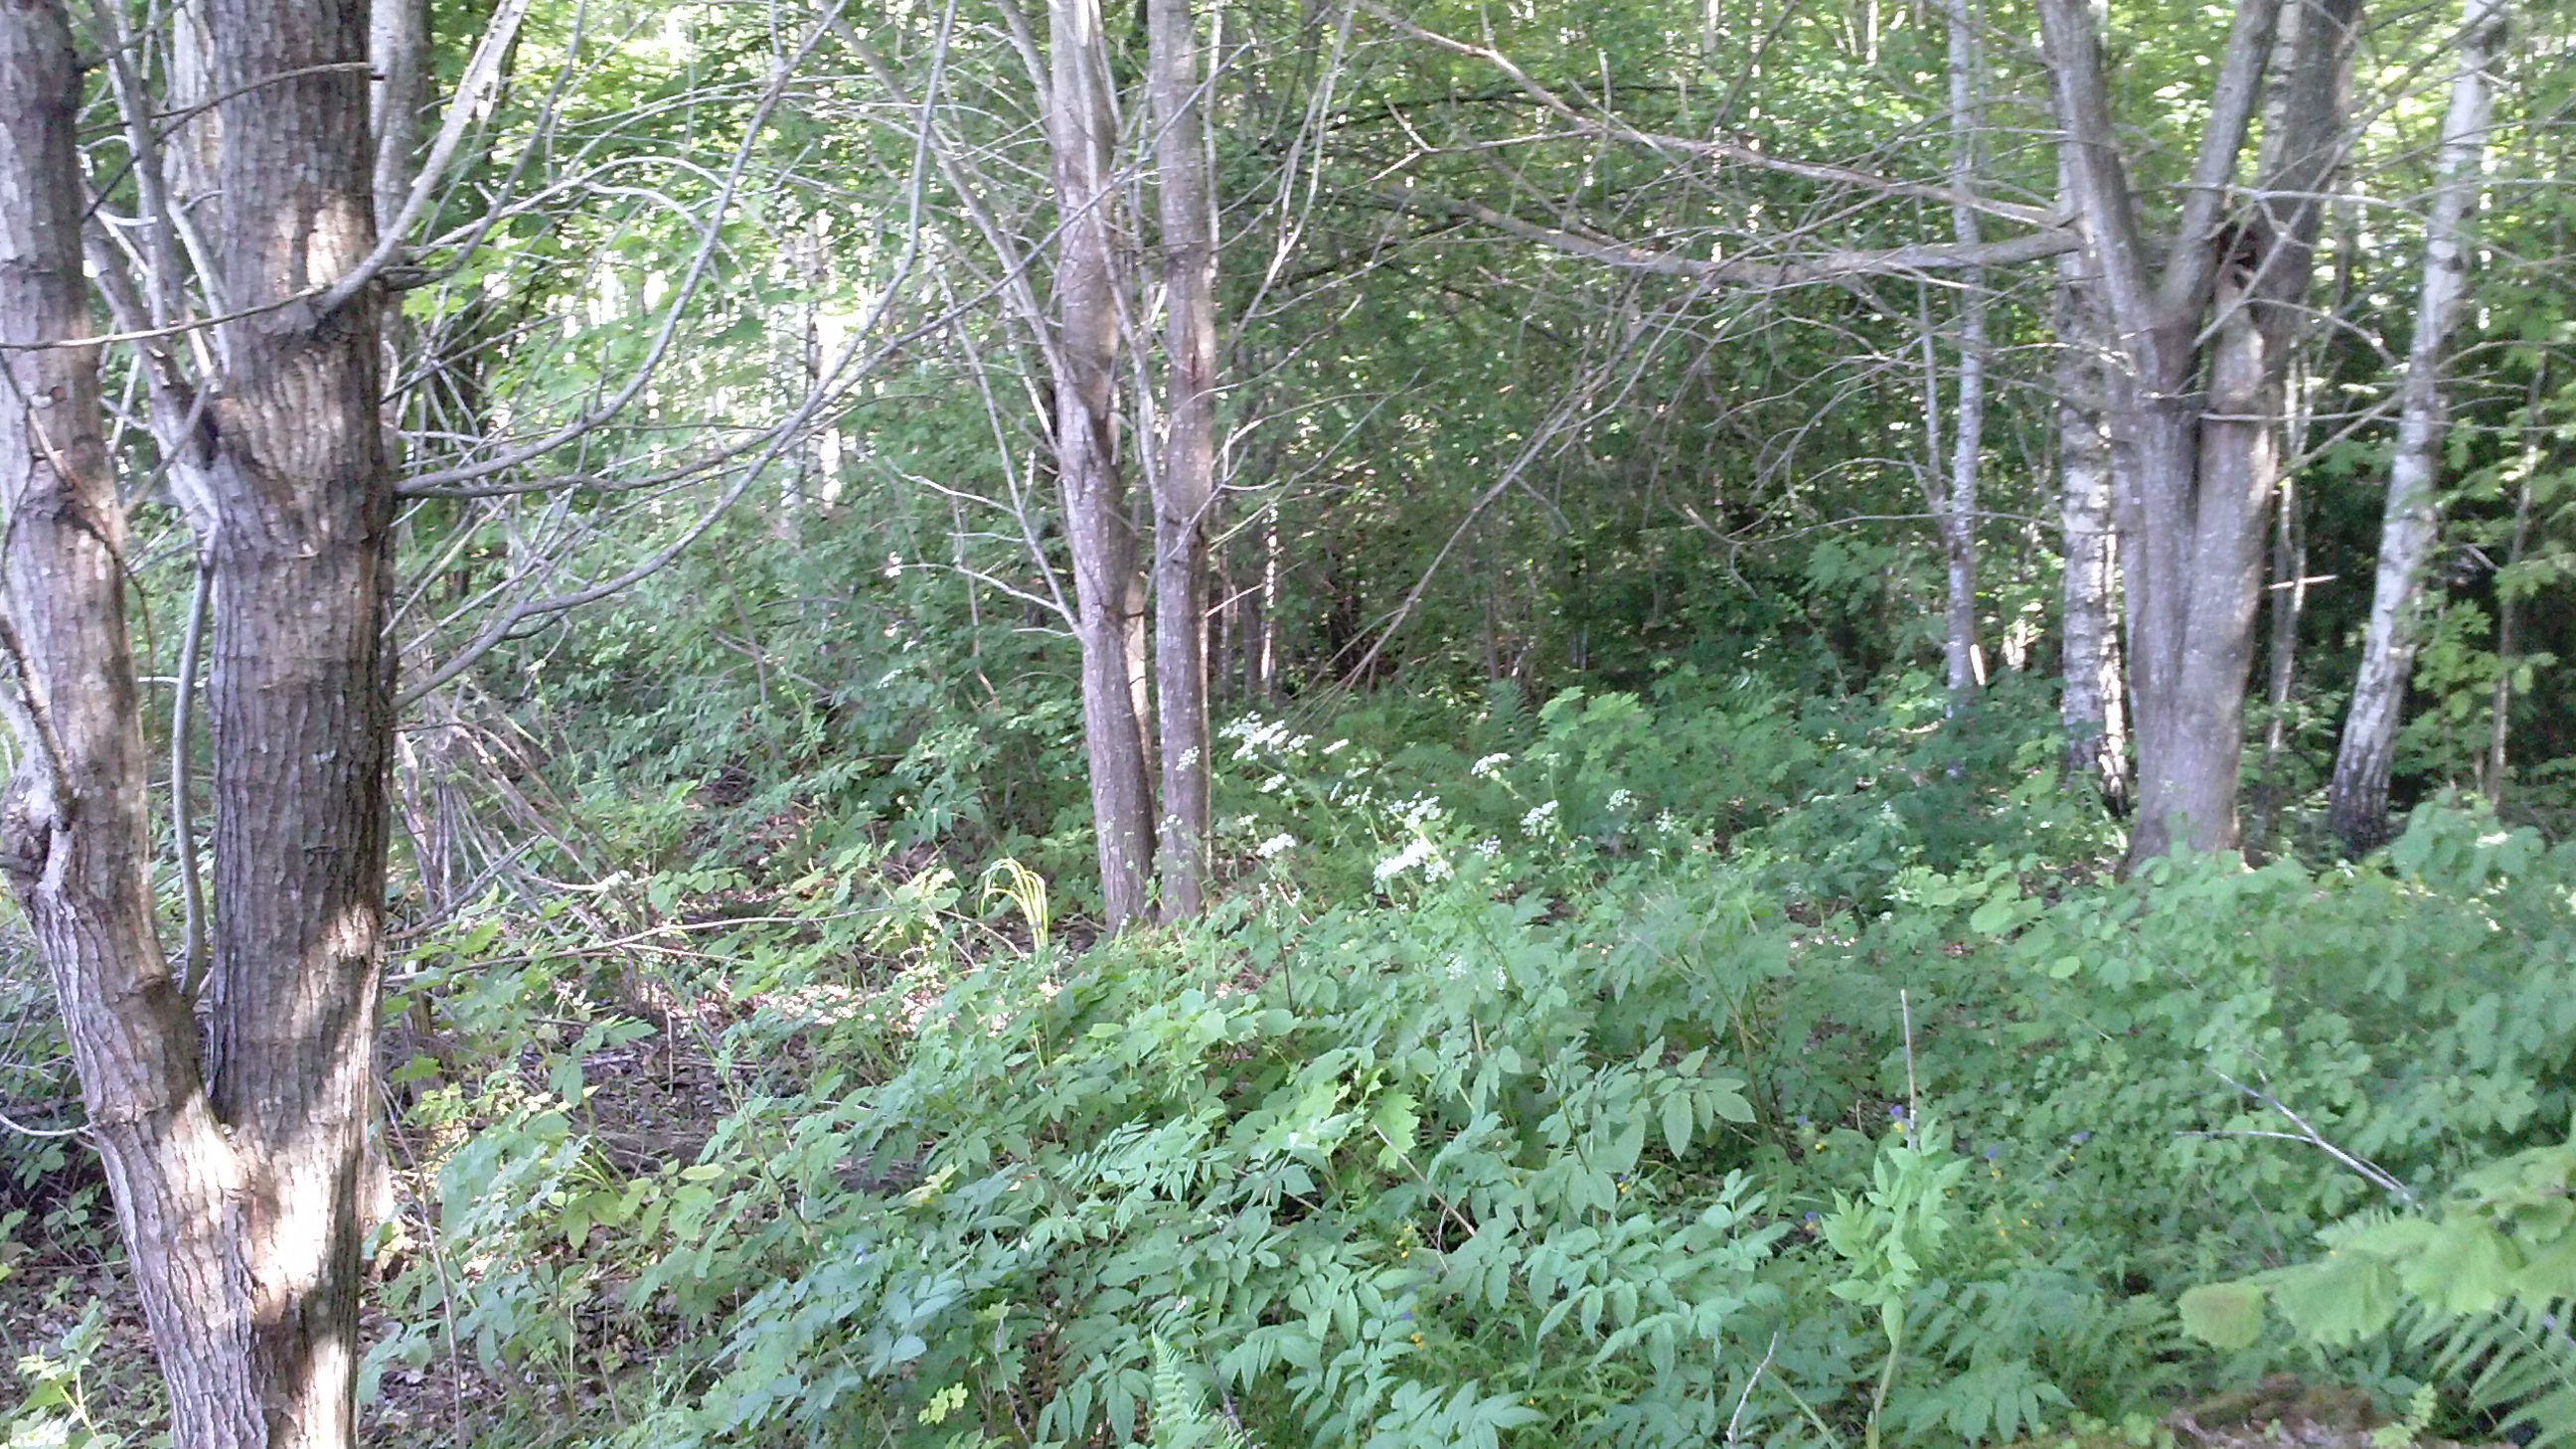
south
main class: Woodland
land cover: Broadleaved woodland
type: non-riverine alder, birch or aspen forest
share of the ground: > 75 %
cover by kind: broadleaved forest trees 80 %, herbaceous plants 10 %, coniferous forest trees 5 %, shrubs 5 %
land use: Forestry
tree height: > 5 m
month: June
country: LV
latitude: 56.5172
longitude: 27.9254
